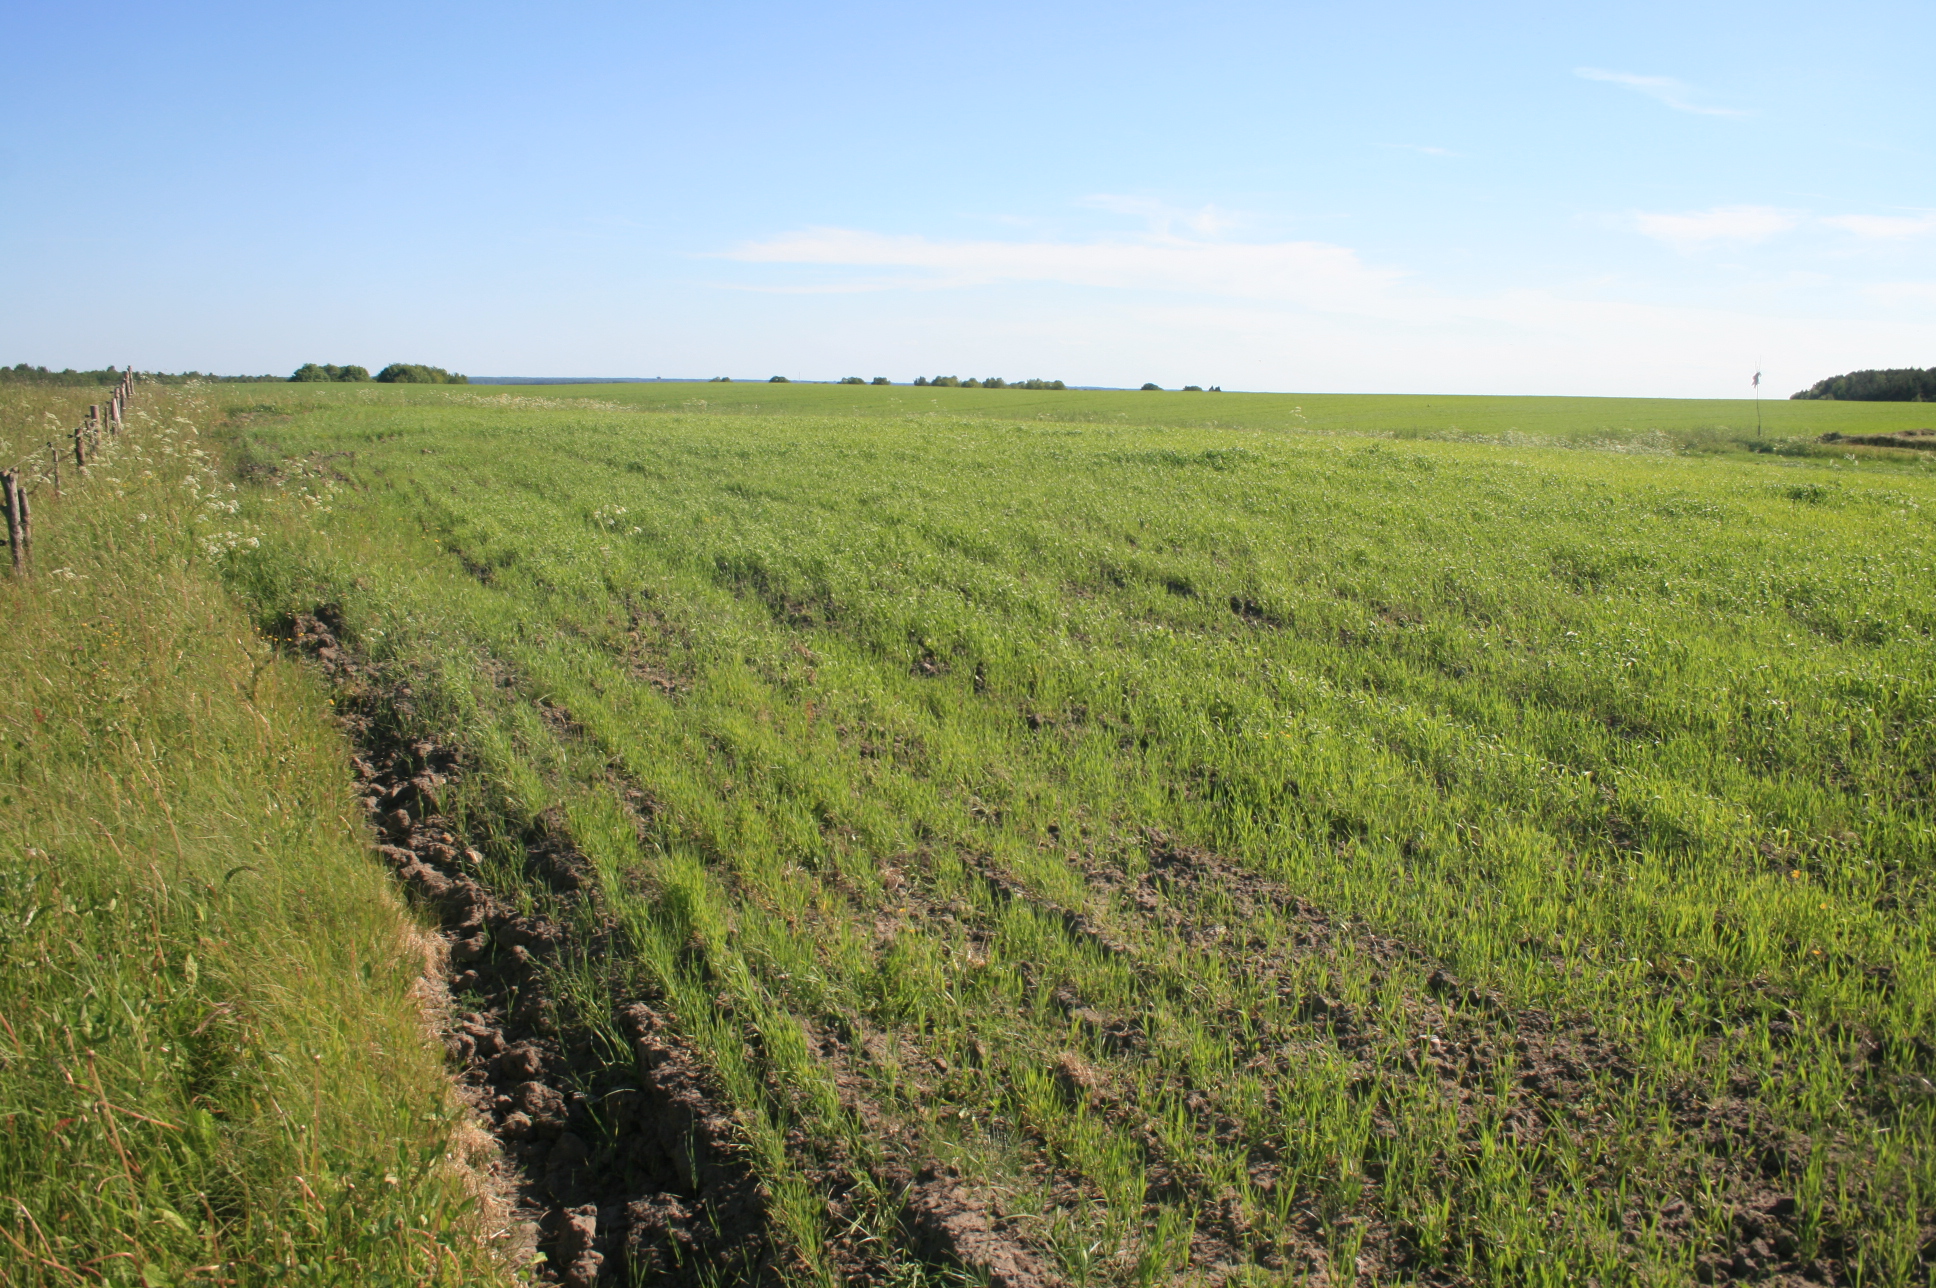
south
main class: Grassland
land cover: Grassland without tree/shrub cover
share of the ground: > 75 %
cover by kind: herbaceous plants 100 %
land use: Agriculture (excluding fallow land and kitchen gardens)
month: June
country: LT
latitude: 55.5471
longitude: 22.2129
